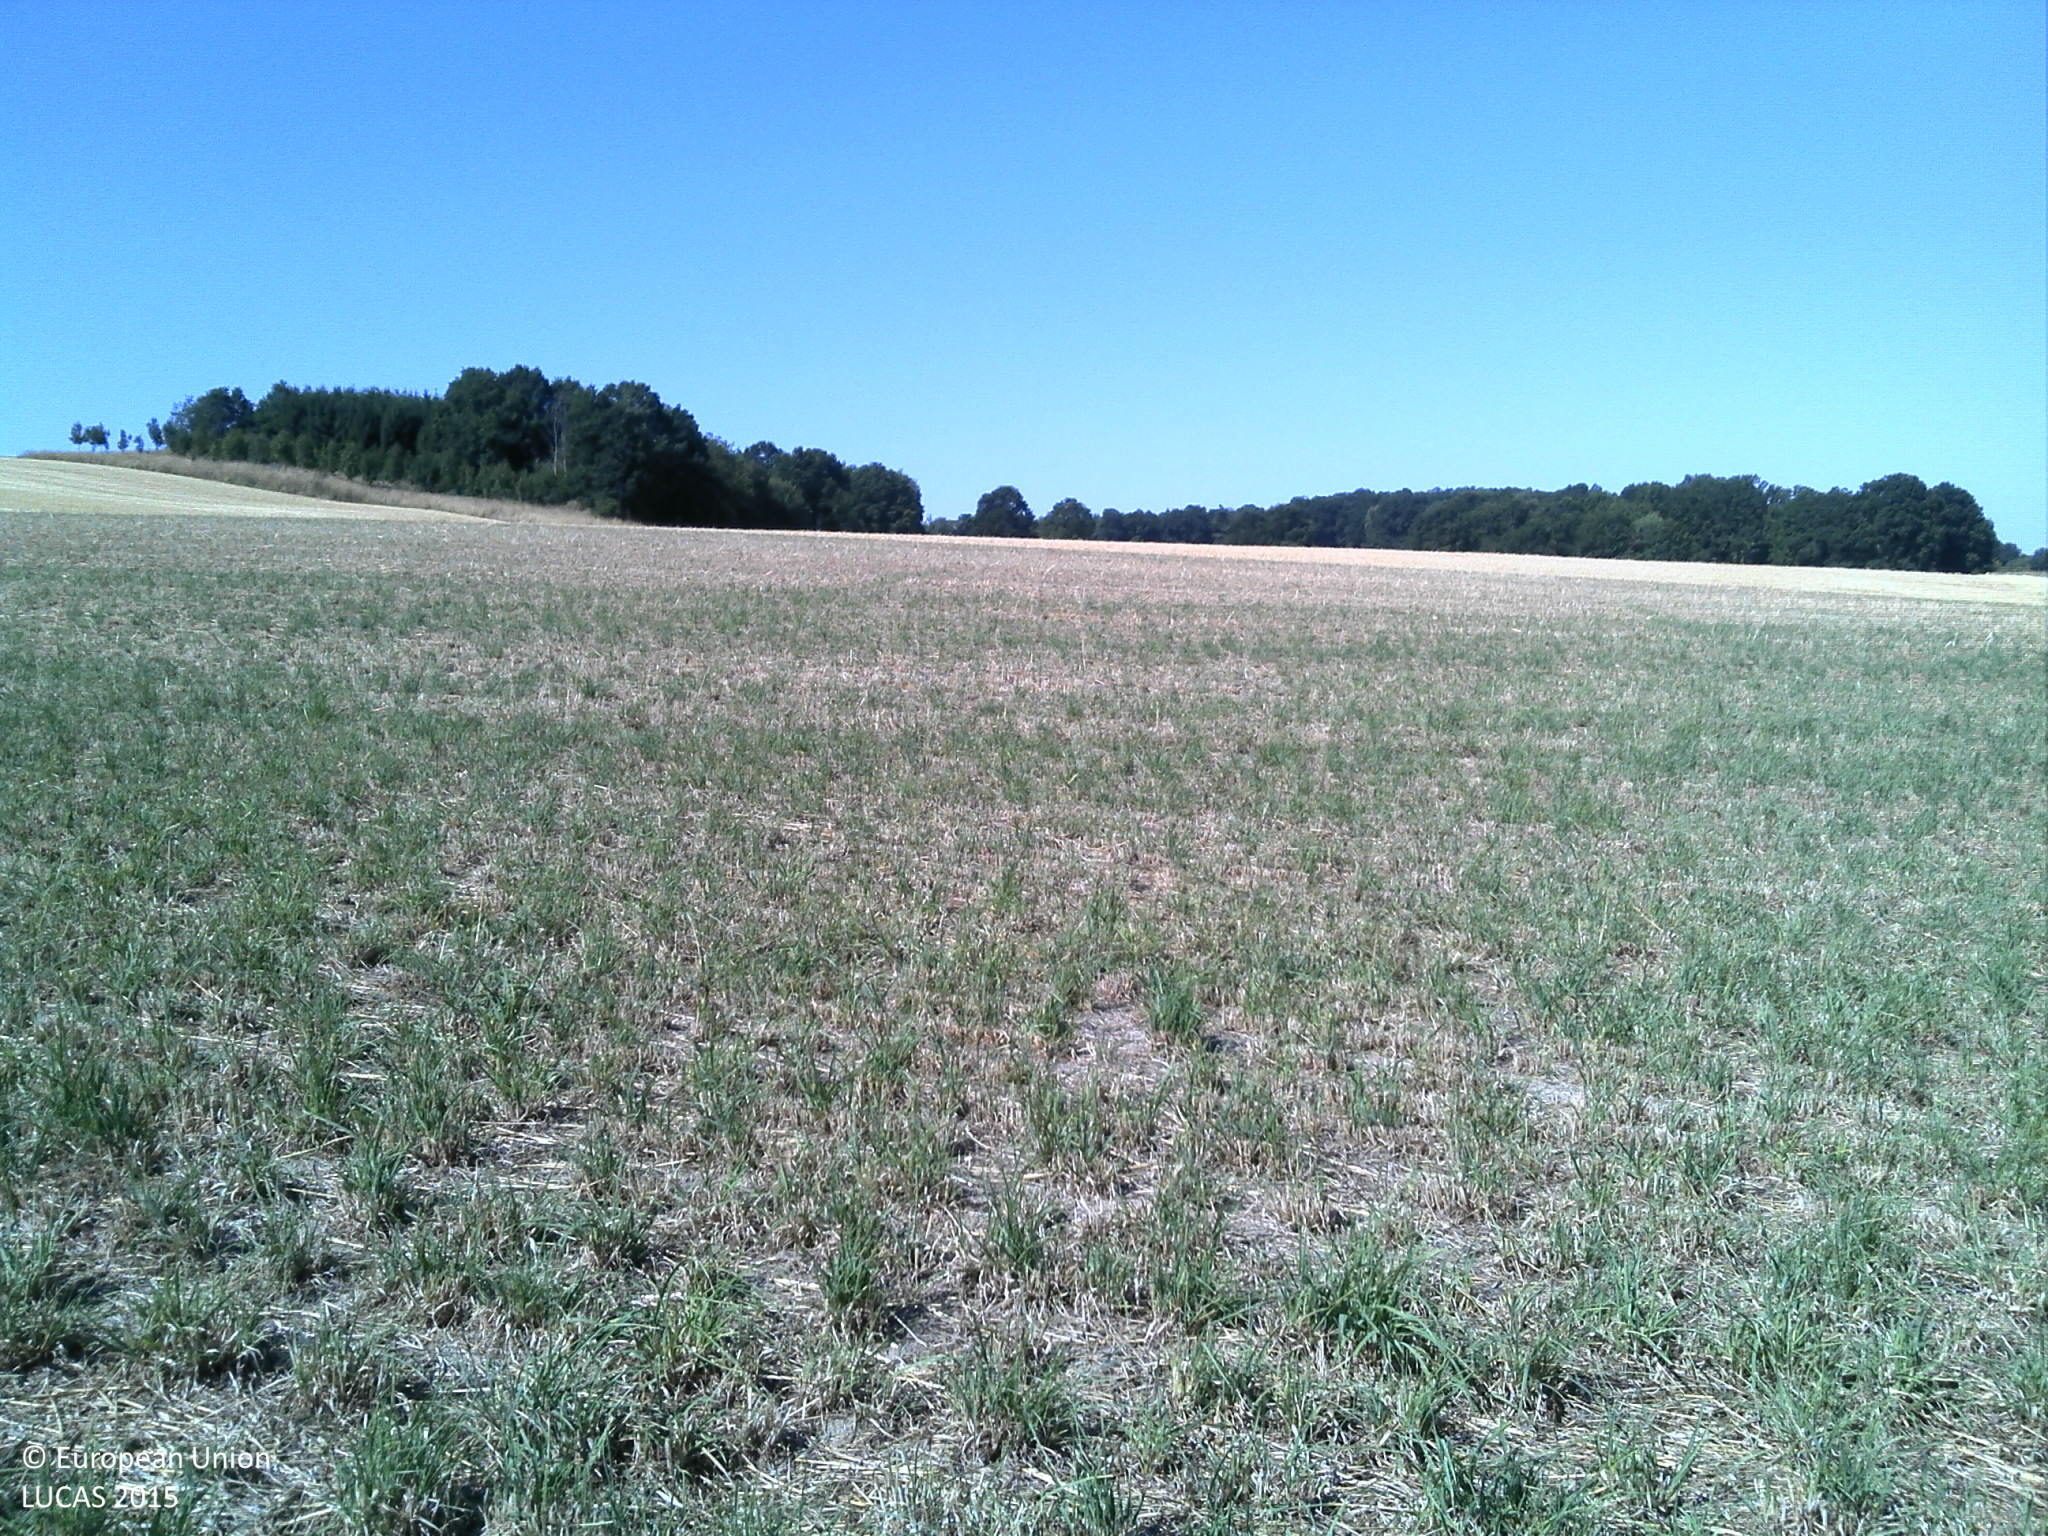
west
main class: Cropland
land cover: Temporary grasslands
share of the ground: > 75 %
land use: Agriculture (excluding fallow land and kitchen gardens)
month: August
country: FR
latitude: 49.1670
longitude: 4.8543
